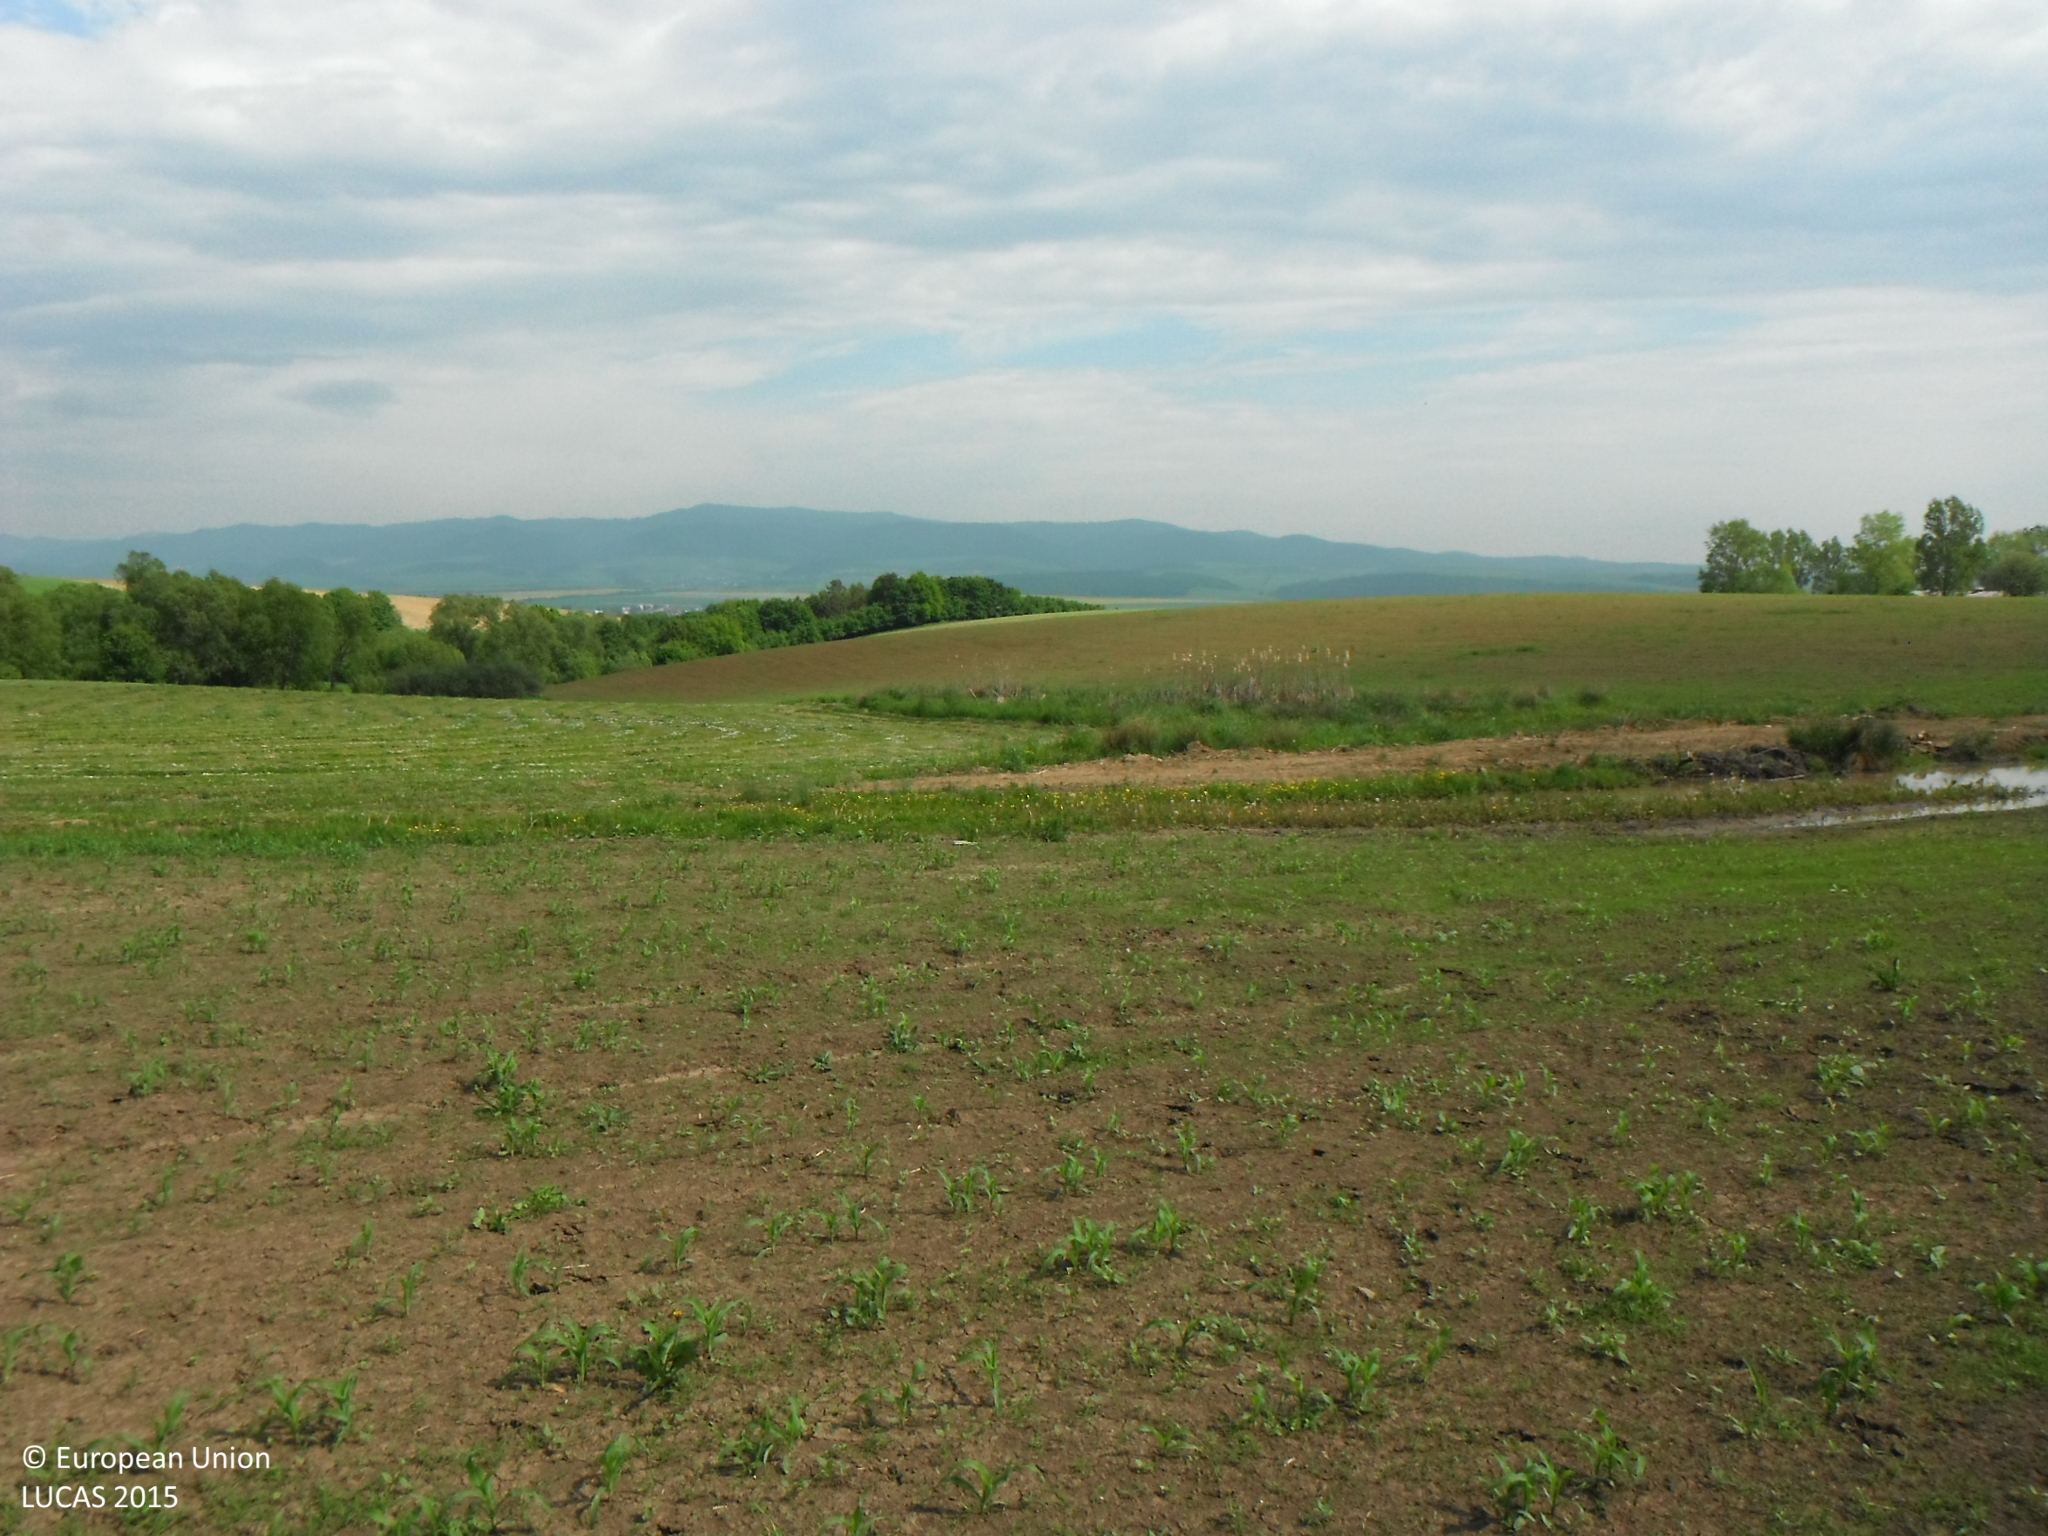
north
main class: Cropland
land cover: Maize
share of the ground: < 10 %
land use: Agriculture (excluding fallow land and kitchen gardens)
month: May
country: SK
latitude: 49.0375
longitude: 21.1375
